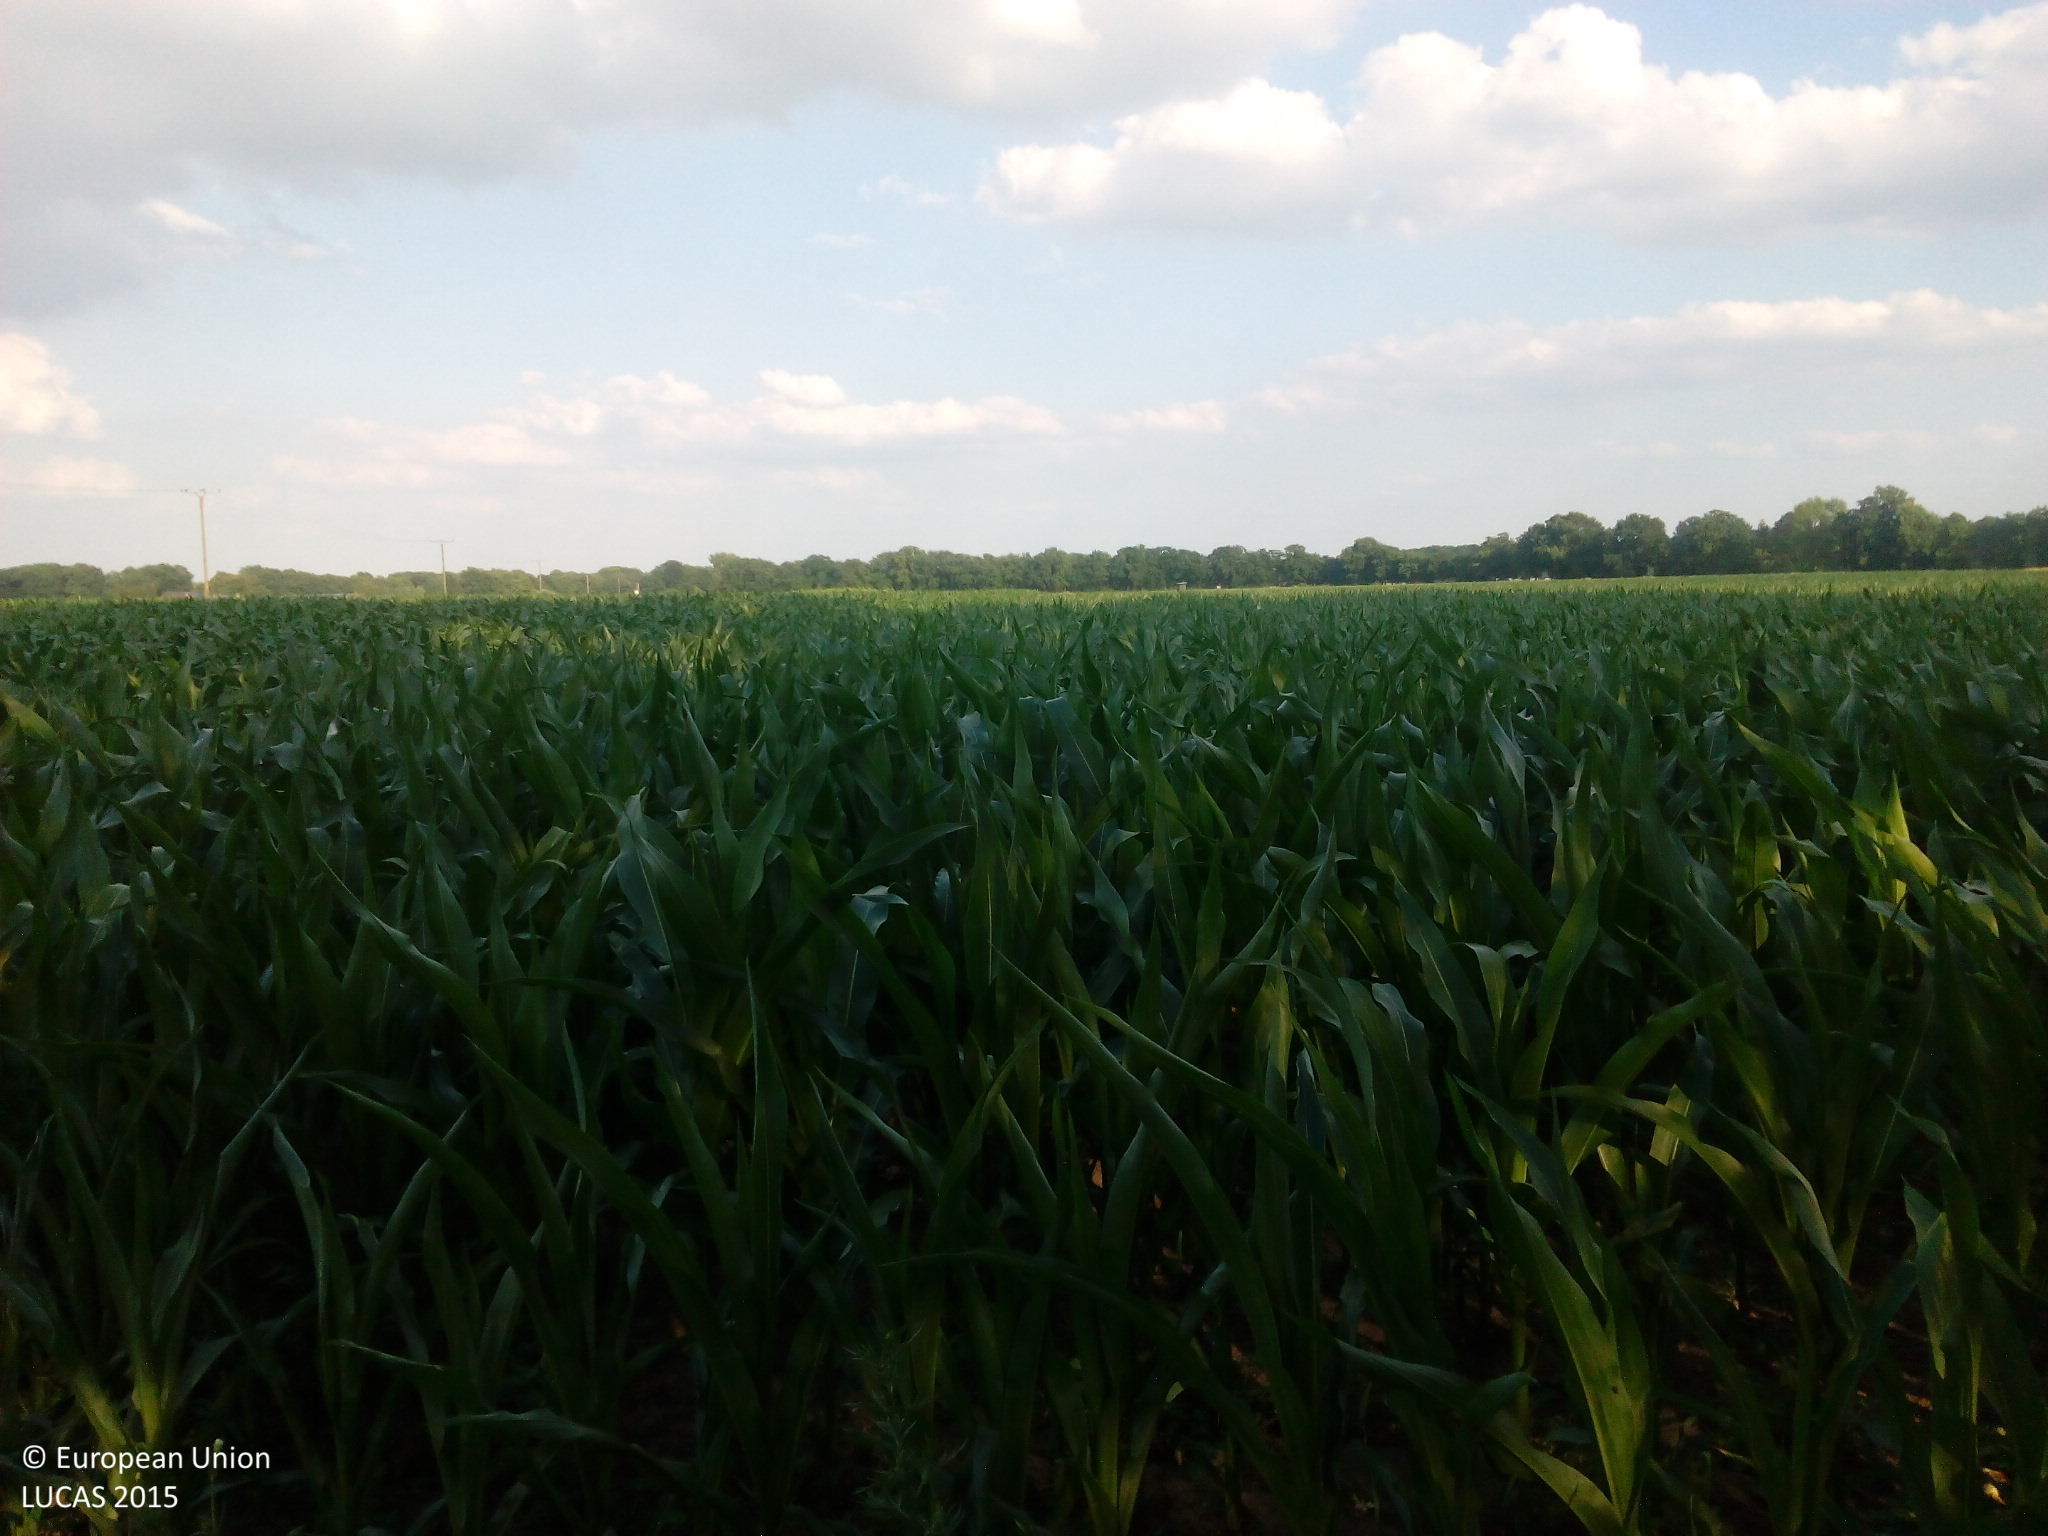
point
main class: Cropland
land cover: Maize
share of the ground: > 75 %
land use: Agriculture (excluding fallow land and kitchen gardens)
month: July
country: DE
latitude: 52.6557
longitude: 7.4429
